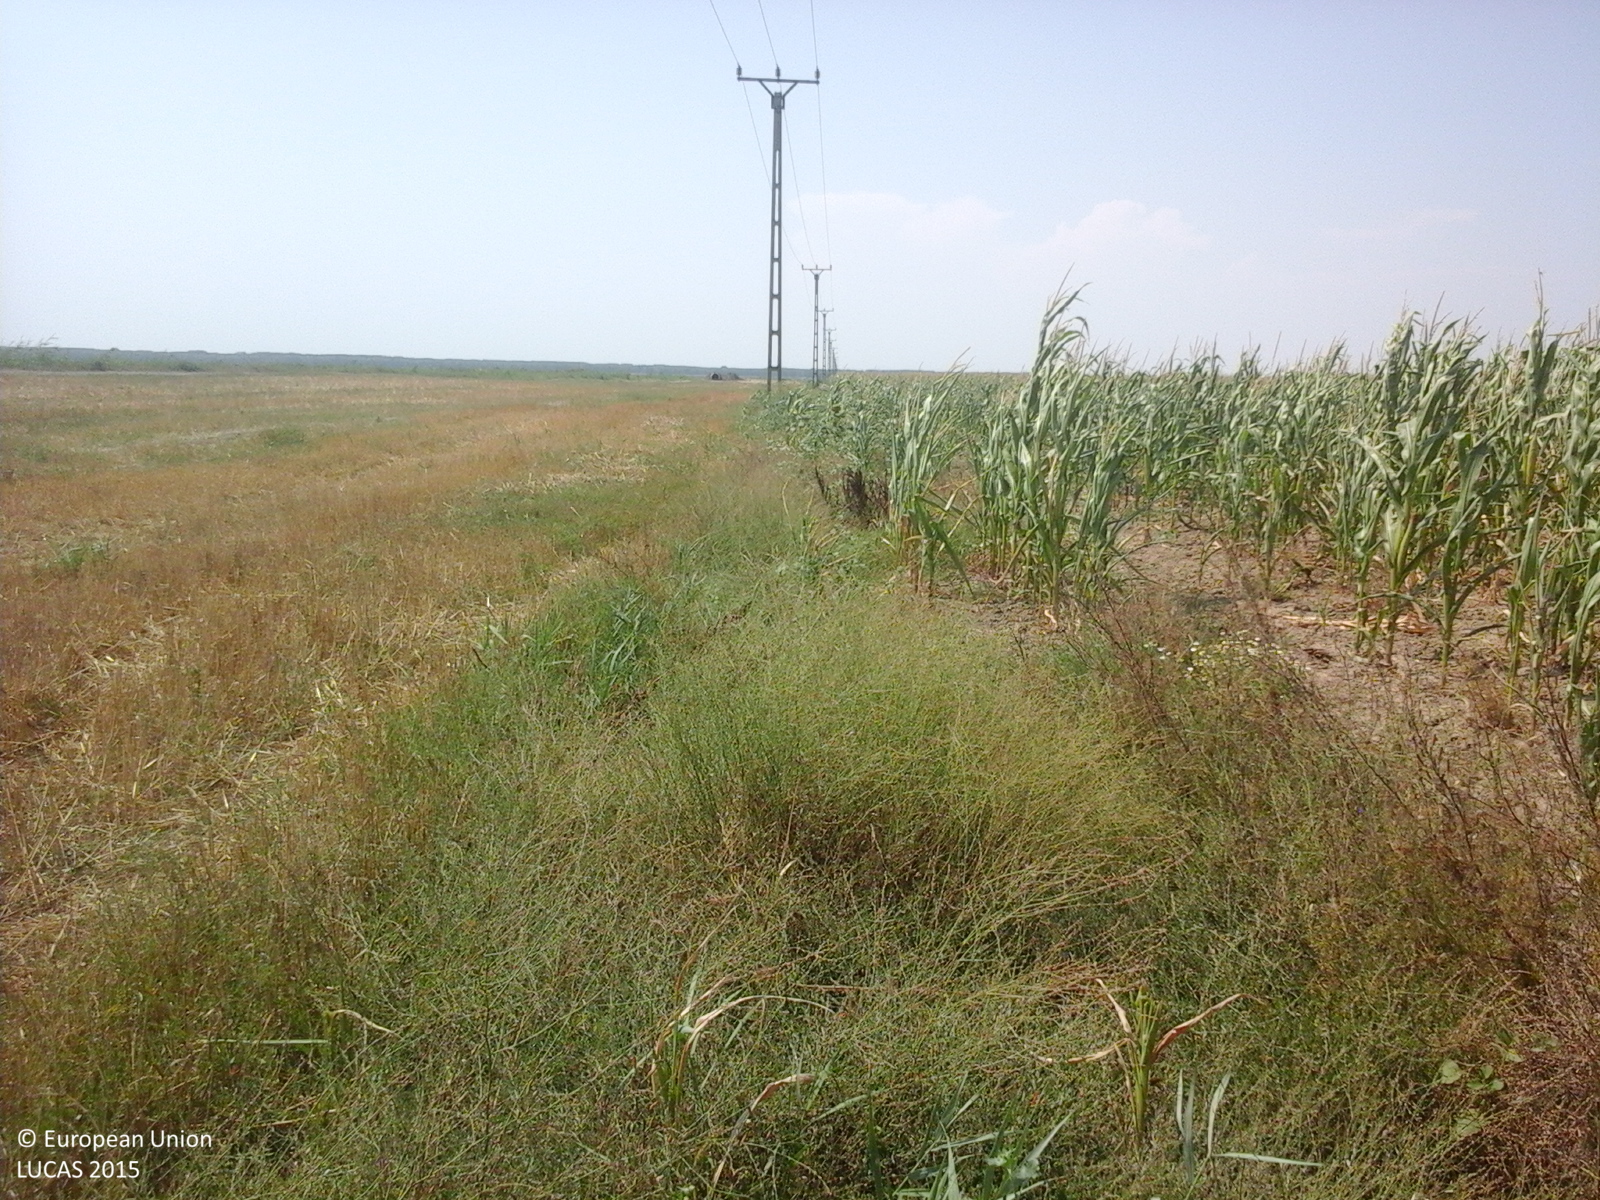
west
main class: Cropland
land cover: Maize
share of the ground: > 75 %
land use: Agriculture (excluding fallow land and kitchen gardens)
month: July
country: RO
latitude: 45.4341
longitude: 27.7890
